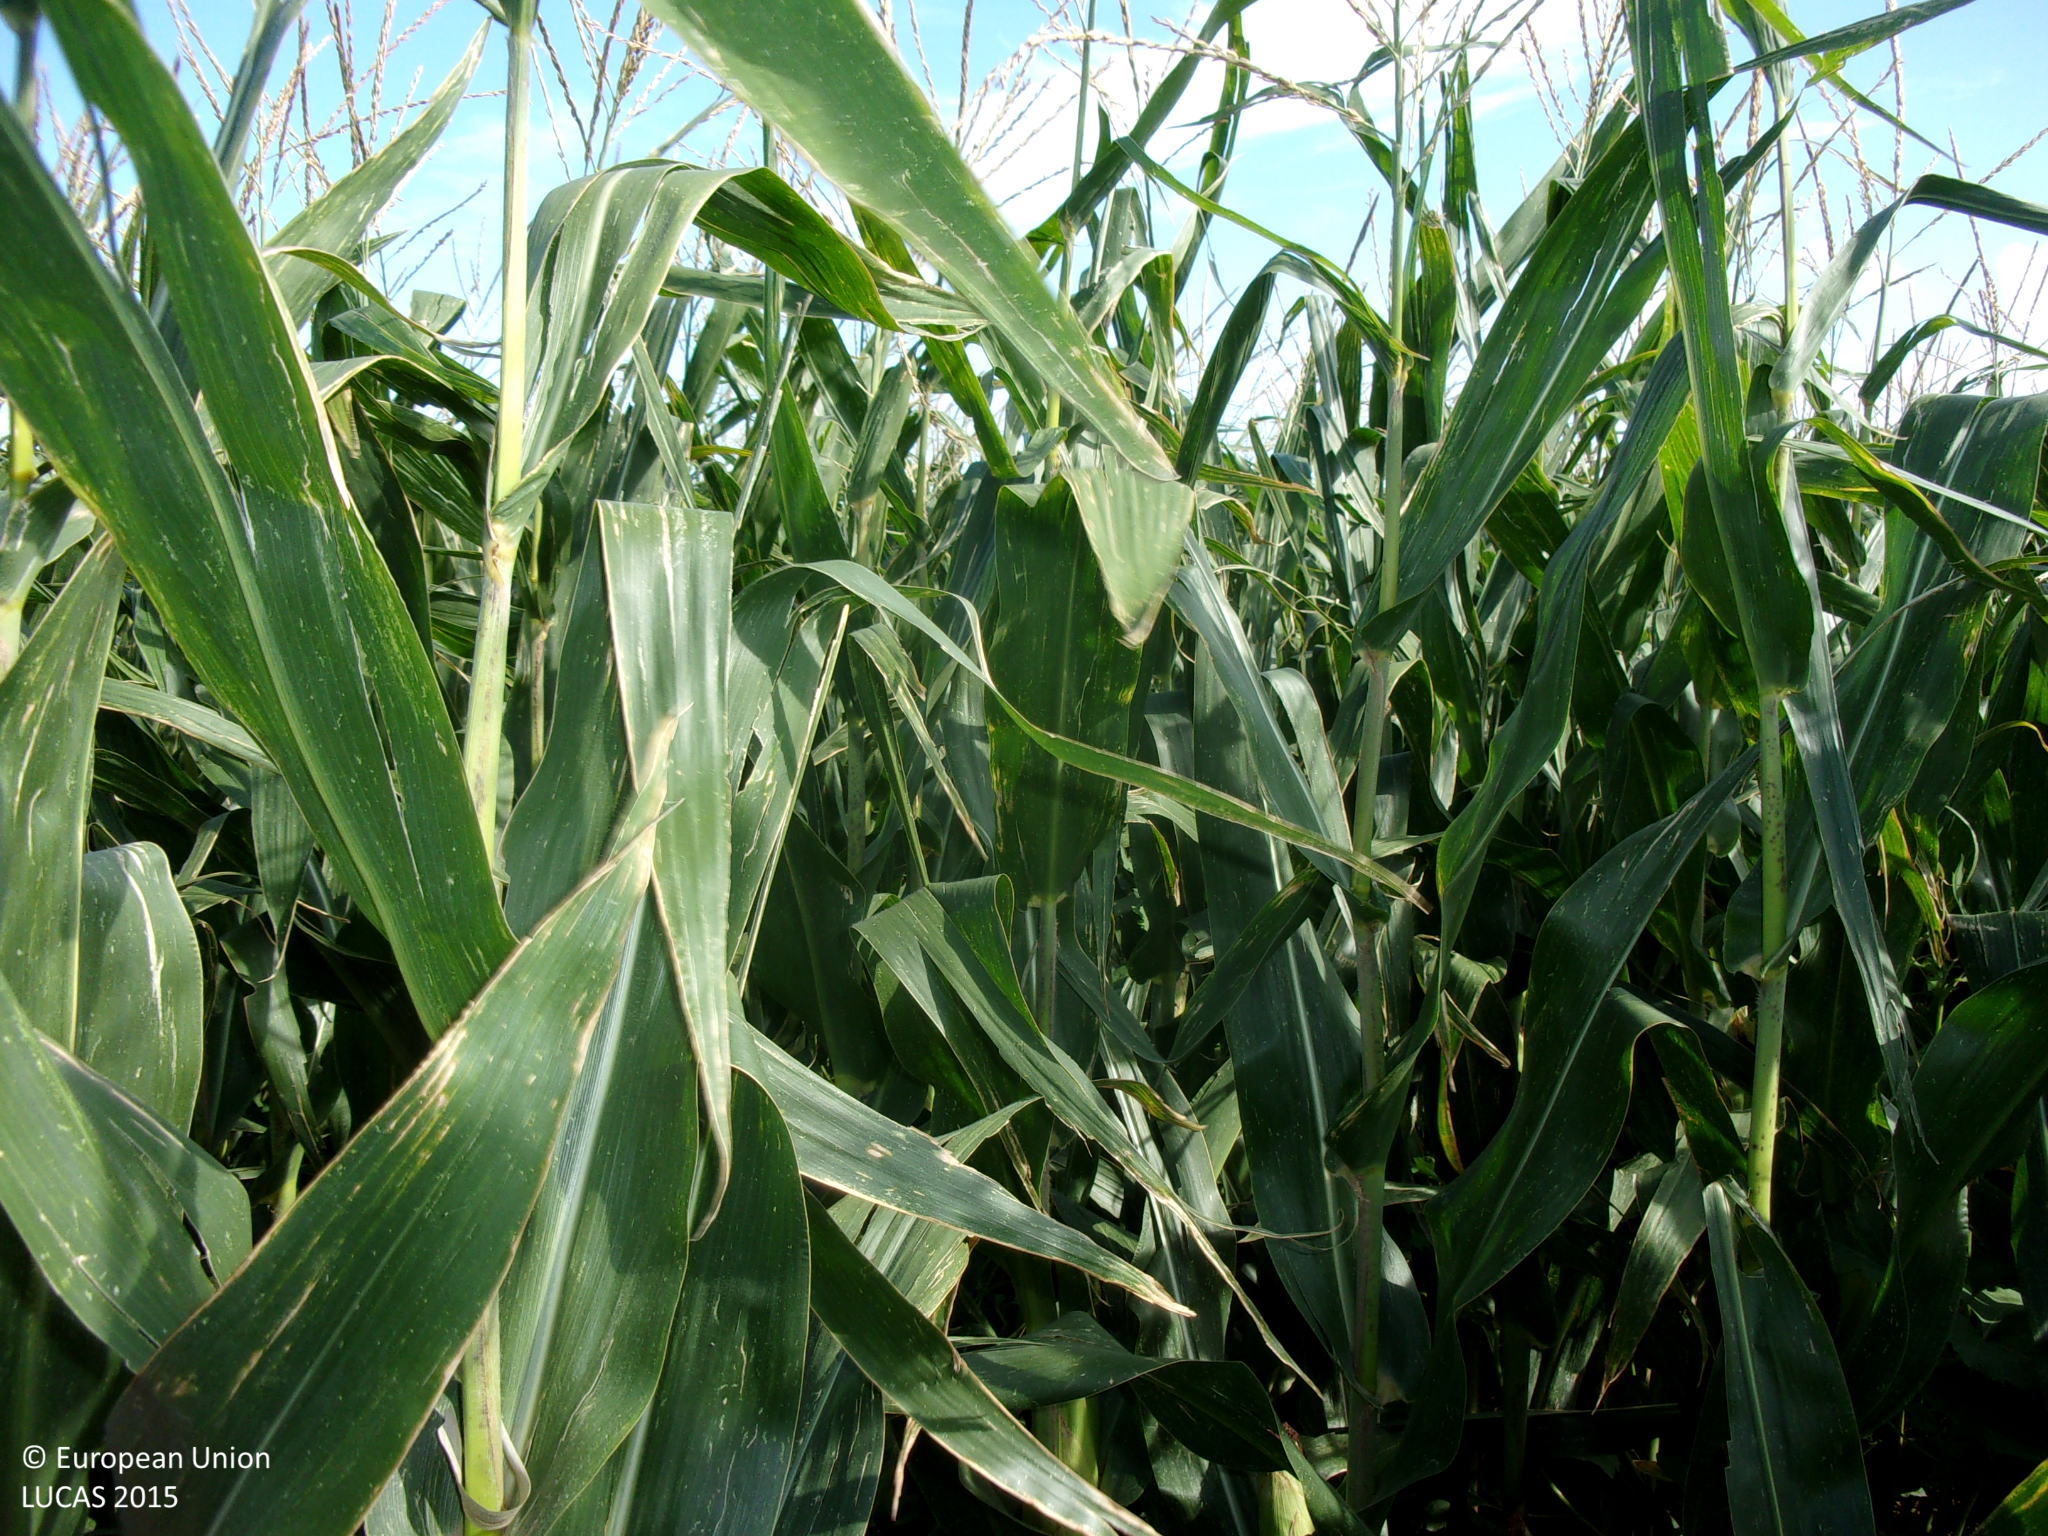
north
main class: Cropland
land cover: Maize
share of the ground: > 75 %
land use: Agriculture (excluding fallow land and kitchen gardens)
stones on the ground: 10 - 25 %
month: August
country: ES
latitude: 42.0593
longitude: -1.1084
